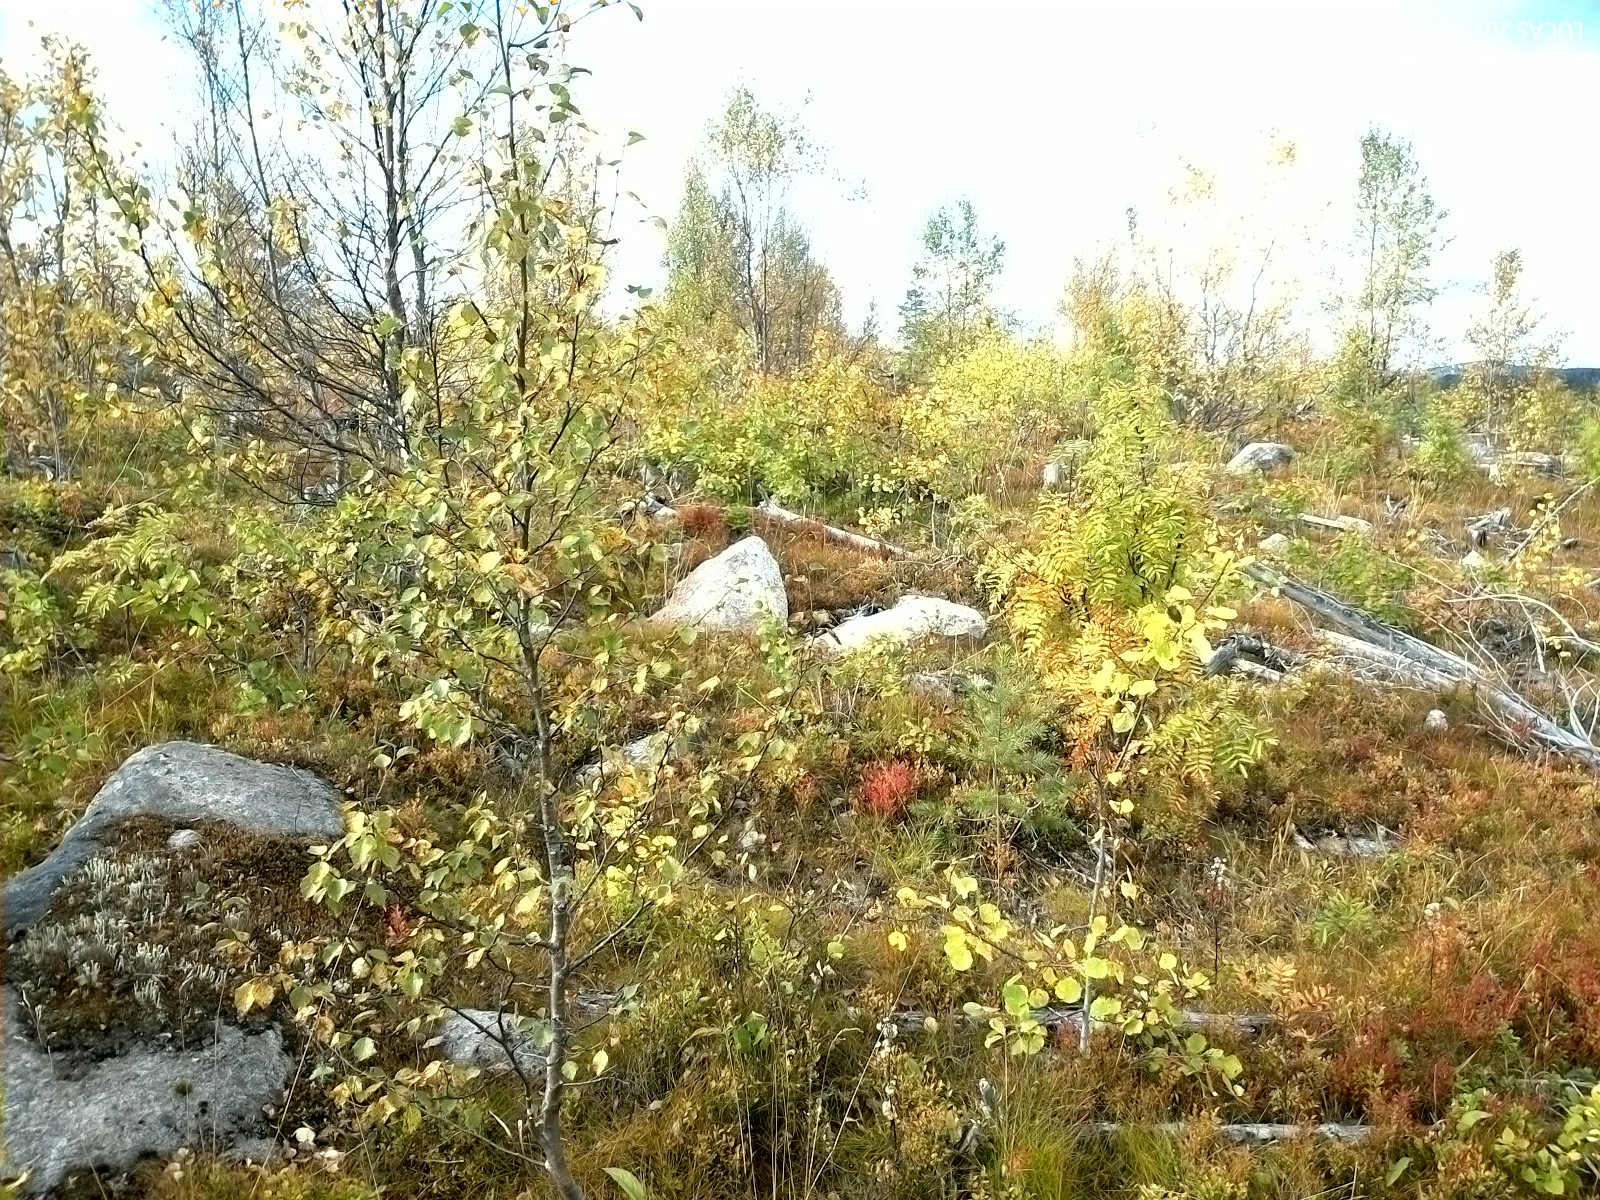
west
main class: Woodland
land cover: Broadleaved woodland
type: boreal forest
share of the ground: 25 - 50 %
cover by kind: herbaceous plants 55 %, broadleaved forest trees 25 %, shrubs 20 %
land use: Forestry
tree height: < 5 m
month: September
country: SE
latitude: 62.2480
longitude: 16.2368
